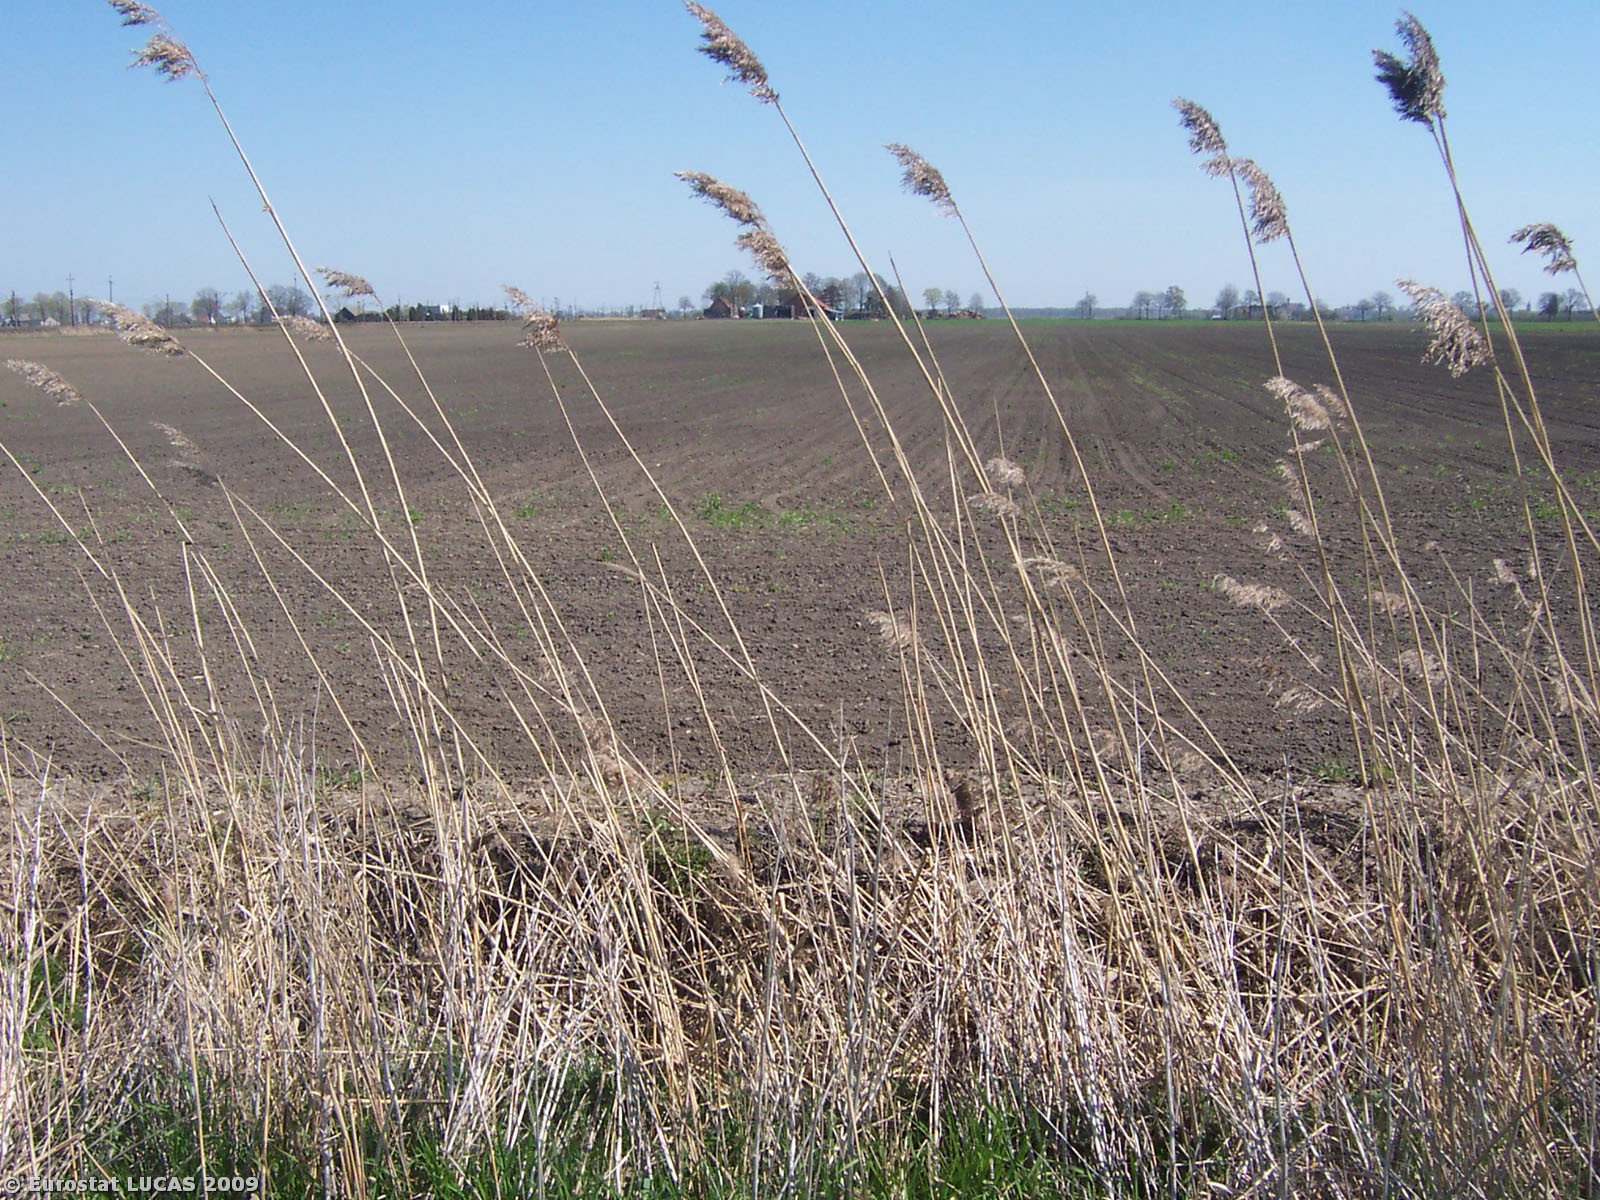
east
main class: Cropland
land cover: Common wheat
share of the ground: 25 - 50 %
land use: Agriculture (excluding fallow land and kitchen gardens)
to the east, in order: Common wheat; Grass margins; Ditches and canals; Rape and turnip rape
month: April
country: PL
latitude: 54.0644
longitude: 18.9595
